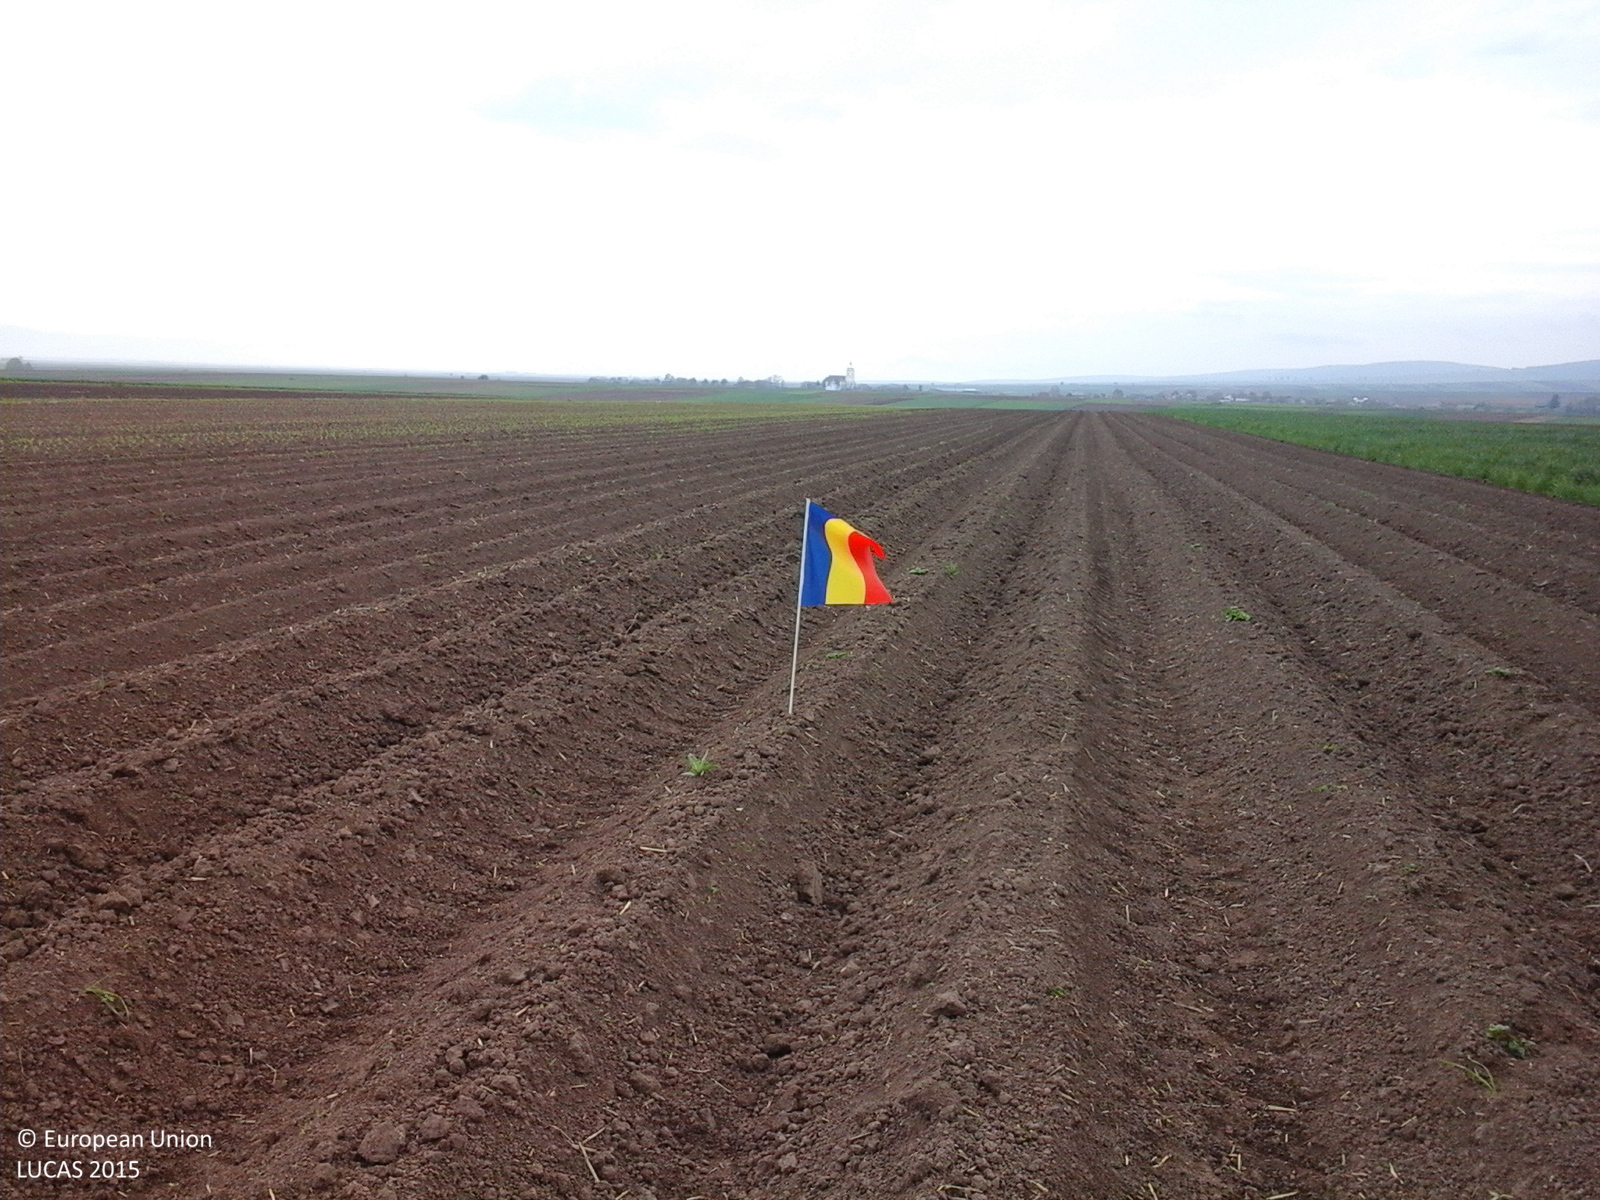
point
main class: Cropland
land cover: Potatoes
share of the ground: < 10 %
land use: Agriculture (excluding fallow land and kitchen gardens)
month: May
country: RO
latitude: 46.0423
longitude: 26.0784
